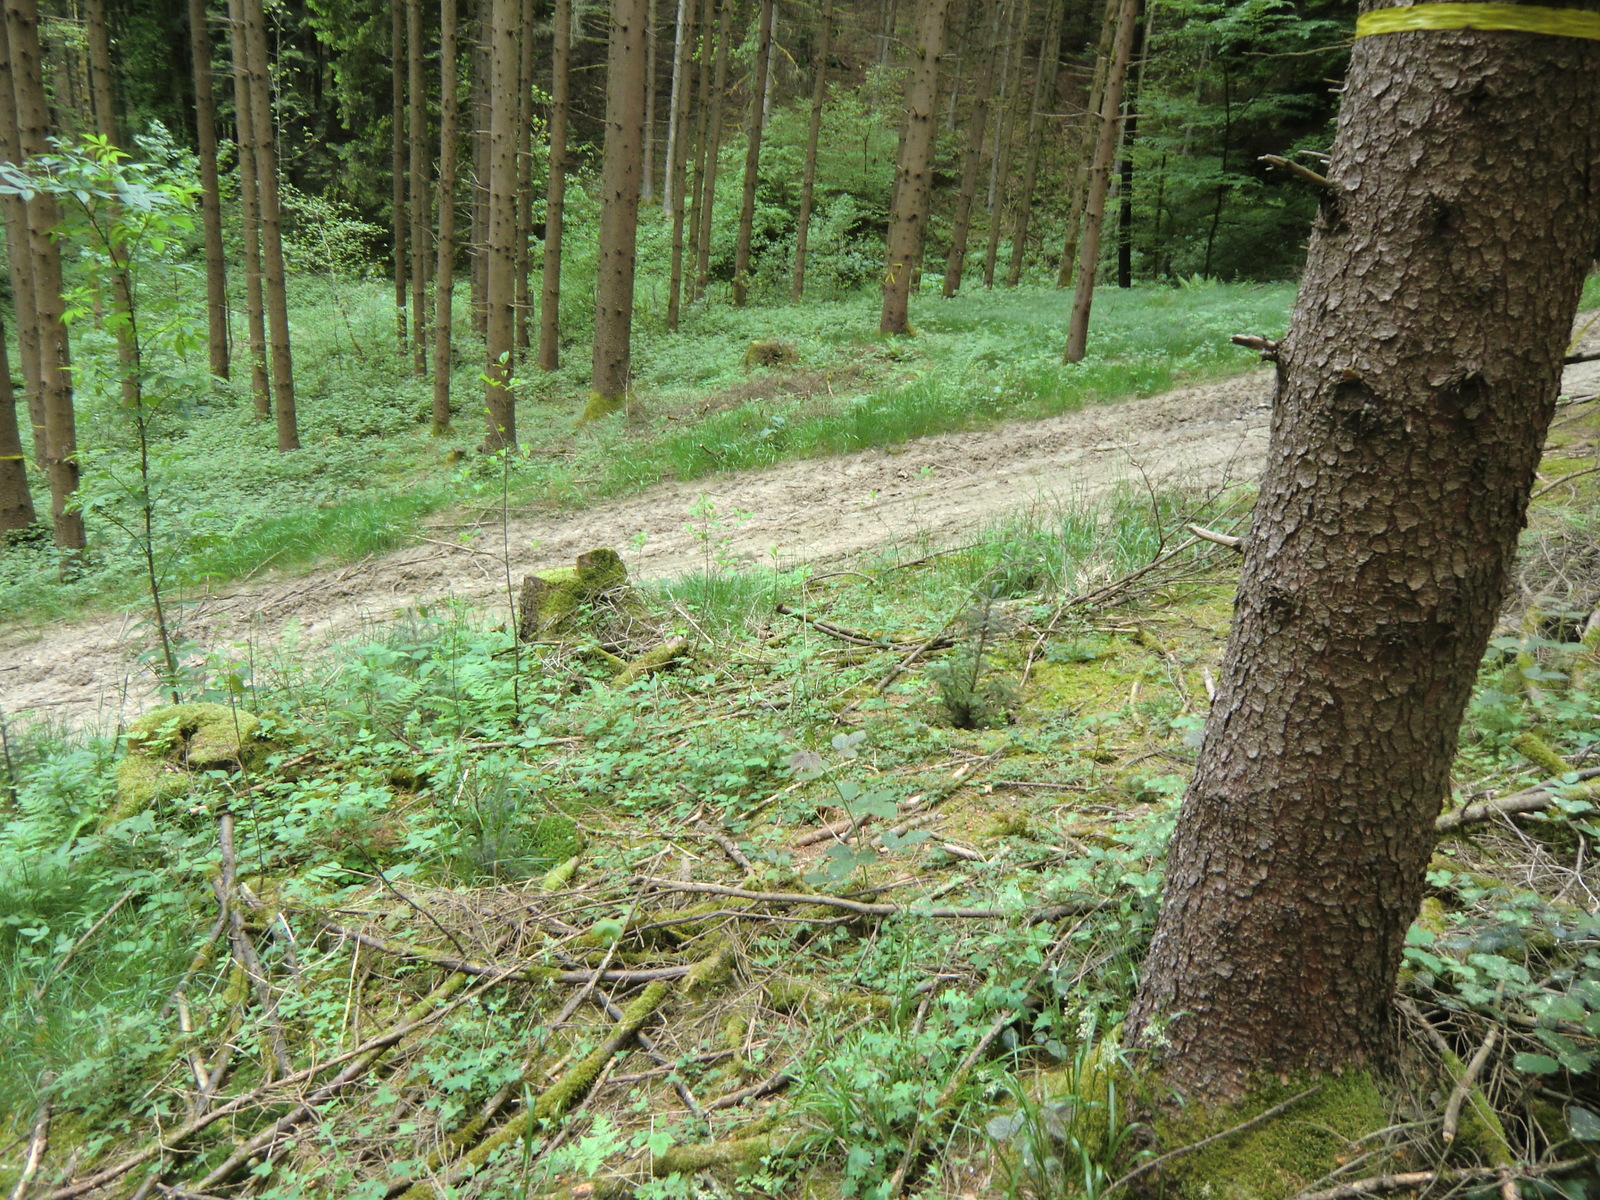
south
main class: Woodland
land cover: Spruce dominated coniferous woodland
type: hemiboreal forest and nemoral coniferous forest and mixed broadleaved-coniferous forest
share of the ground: > 75 %
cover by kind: coniferous forest trees 85 %, lichens and mosses 10 %, consolidated bare surface 5 %
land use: Forestry
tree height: > 5 m
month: May
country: AT
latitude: 48.2078
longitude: 14.8318
